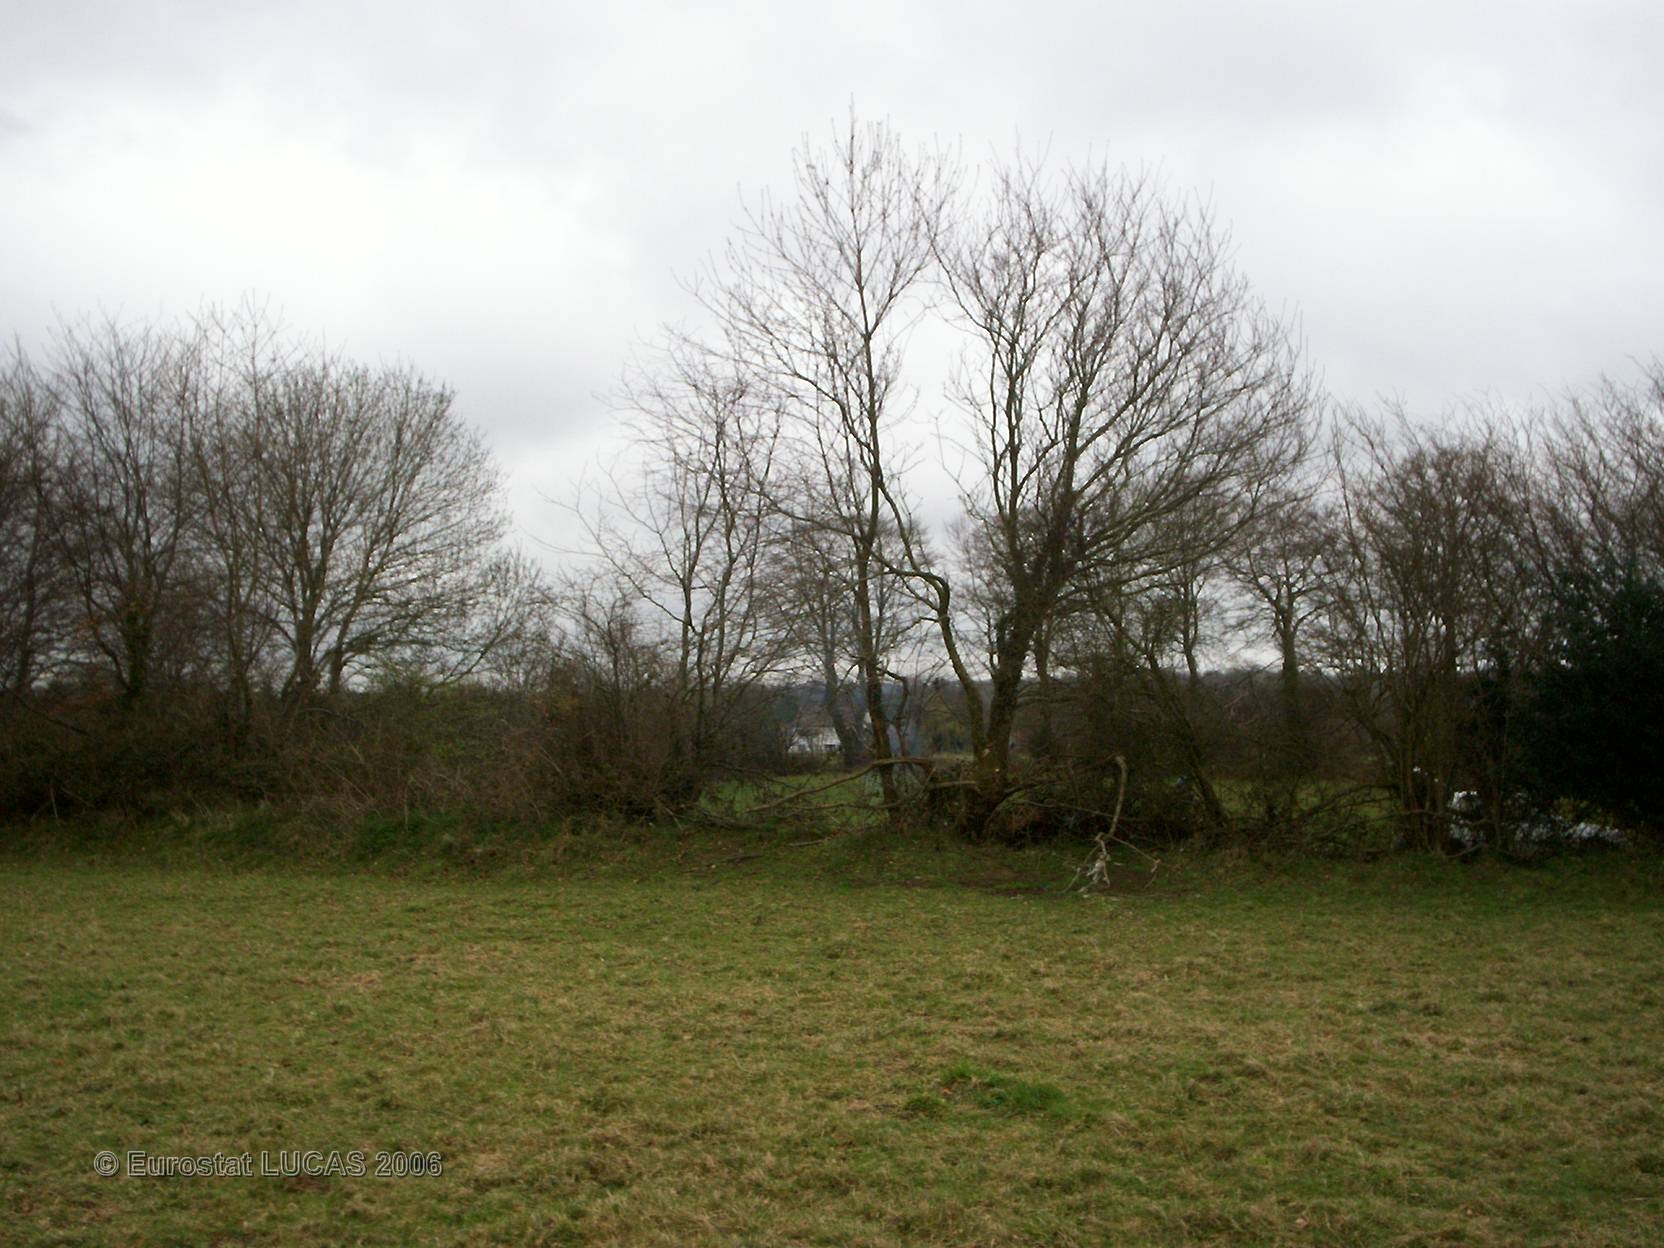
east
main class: Grassland
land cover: Grassland without tree/shrub cover
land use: Agriculture (excluding fallow land and kitchen gardens)
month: April
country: FR
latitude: 49.5719
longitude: -1.5975
